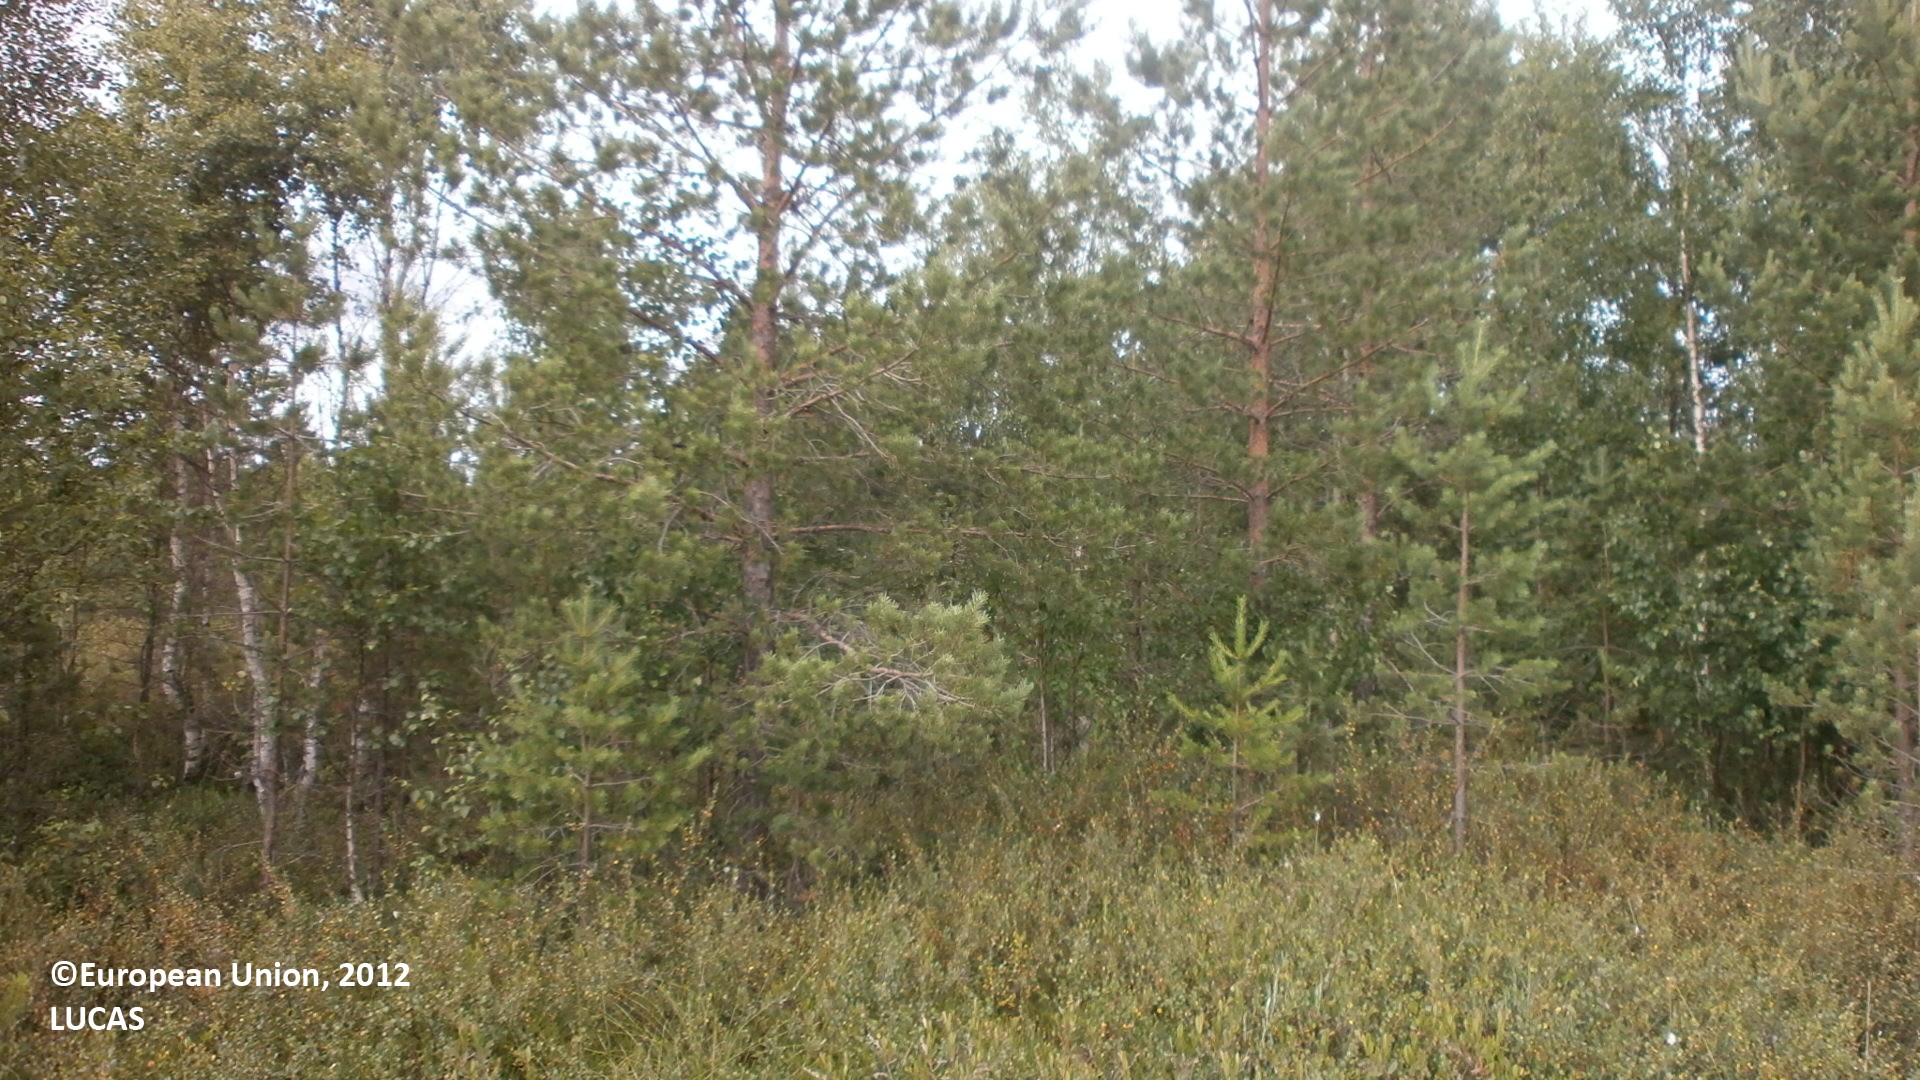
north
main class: Woodland
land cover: Pine dominated coniferous woodland
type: mire and swamp forests
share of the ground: 10 - 25 %
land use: Forestry
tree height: > 5 m
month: July
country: FI
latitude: 63.9526
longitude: 24.2564
